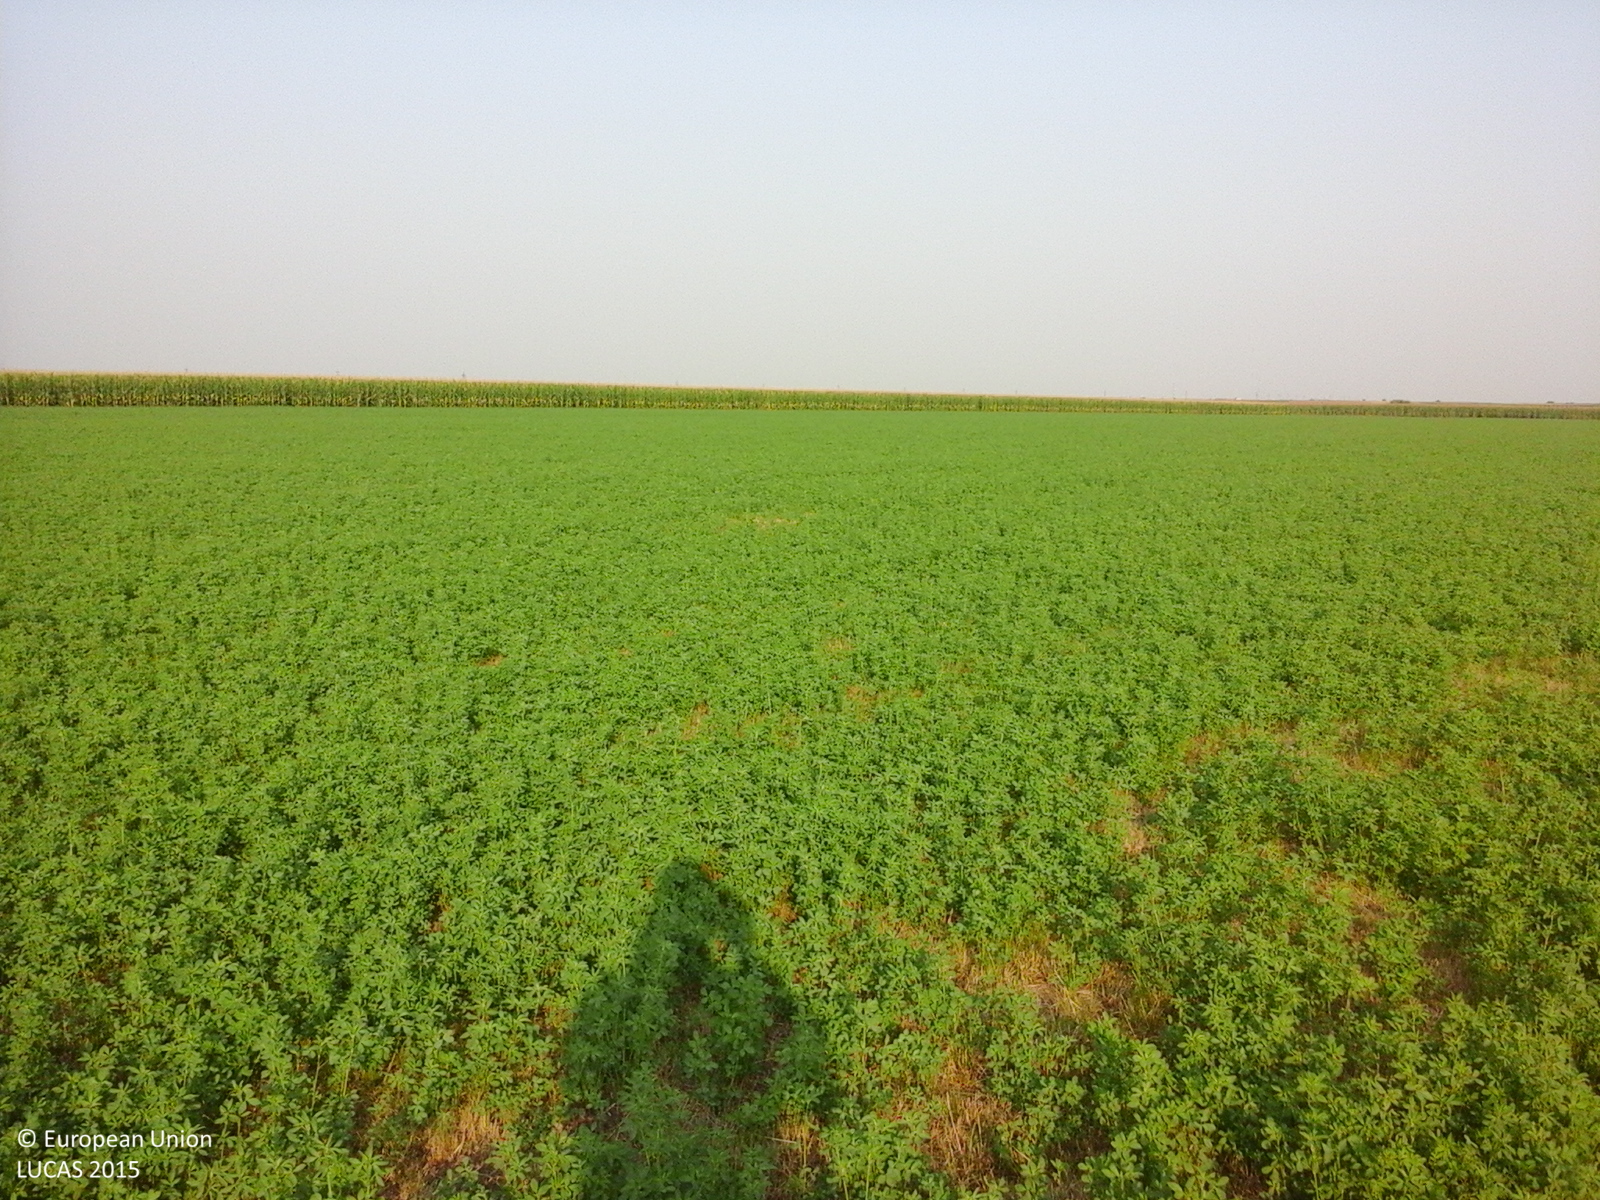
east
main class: Cropland
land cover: Lucerne
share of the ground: > 75 %
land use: Agriculture (excluding fallow land and kitchen gardens)
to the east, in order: Lucerne; Maize
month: July
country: RO
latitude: 44.5024
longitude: 26.5301
